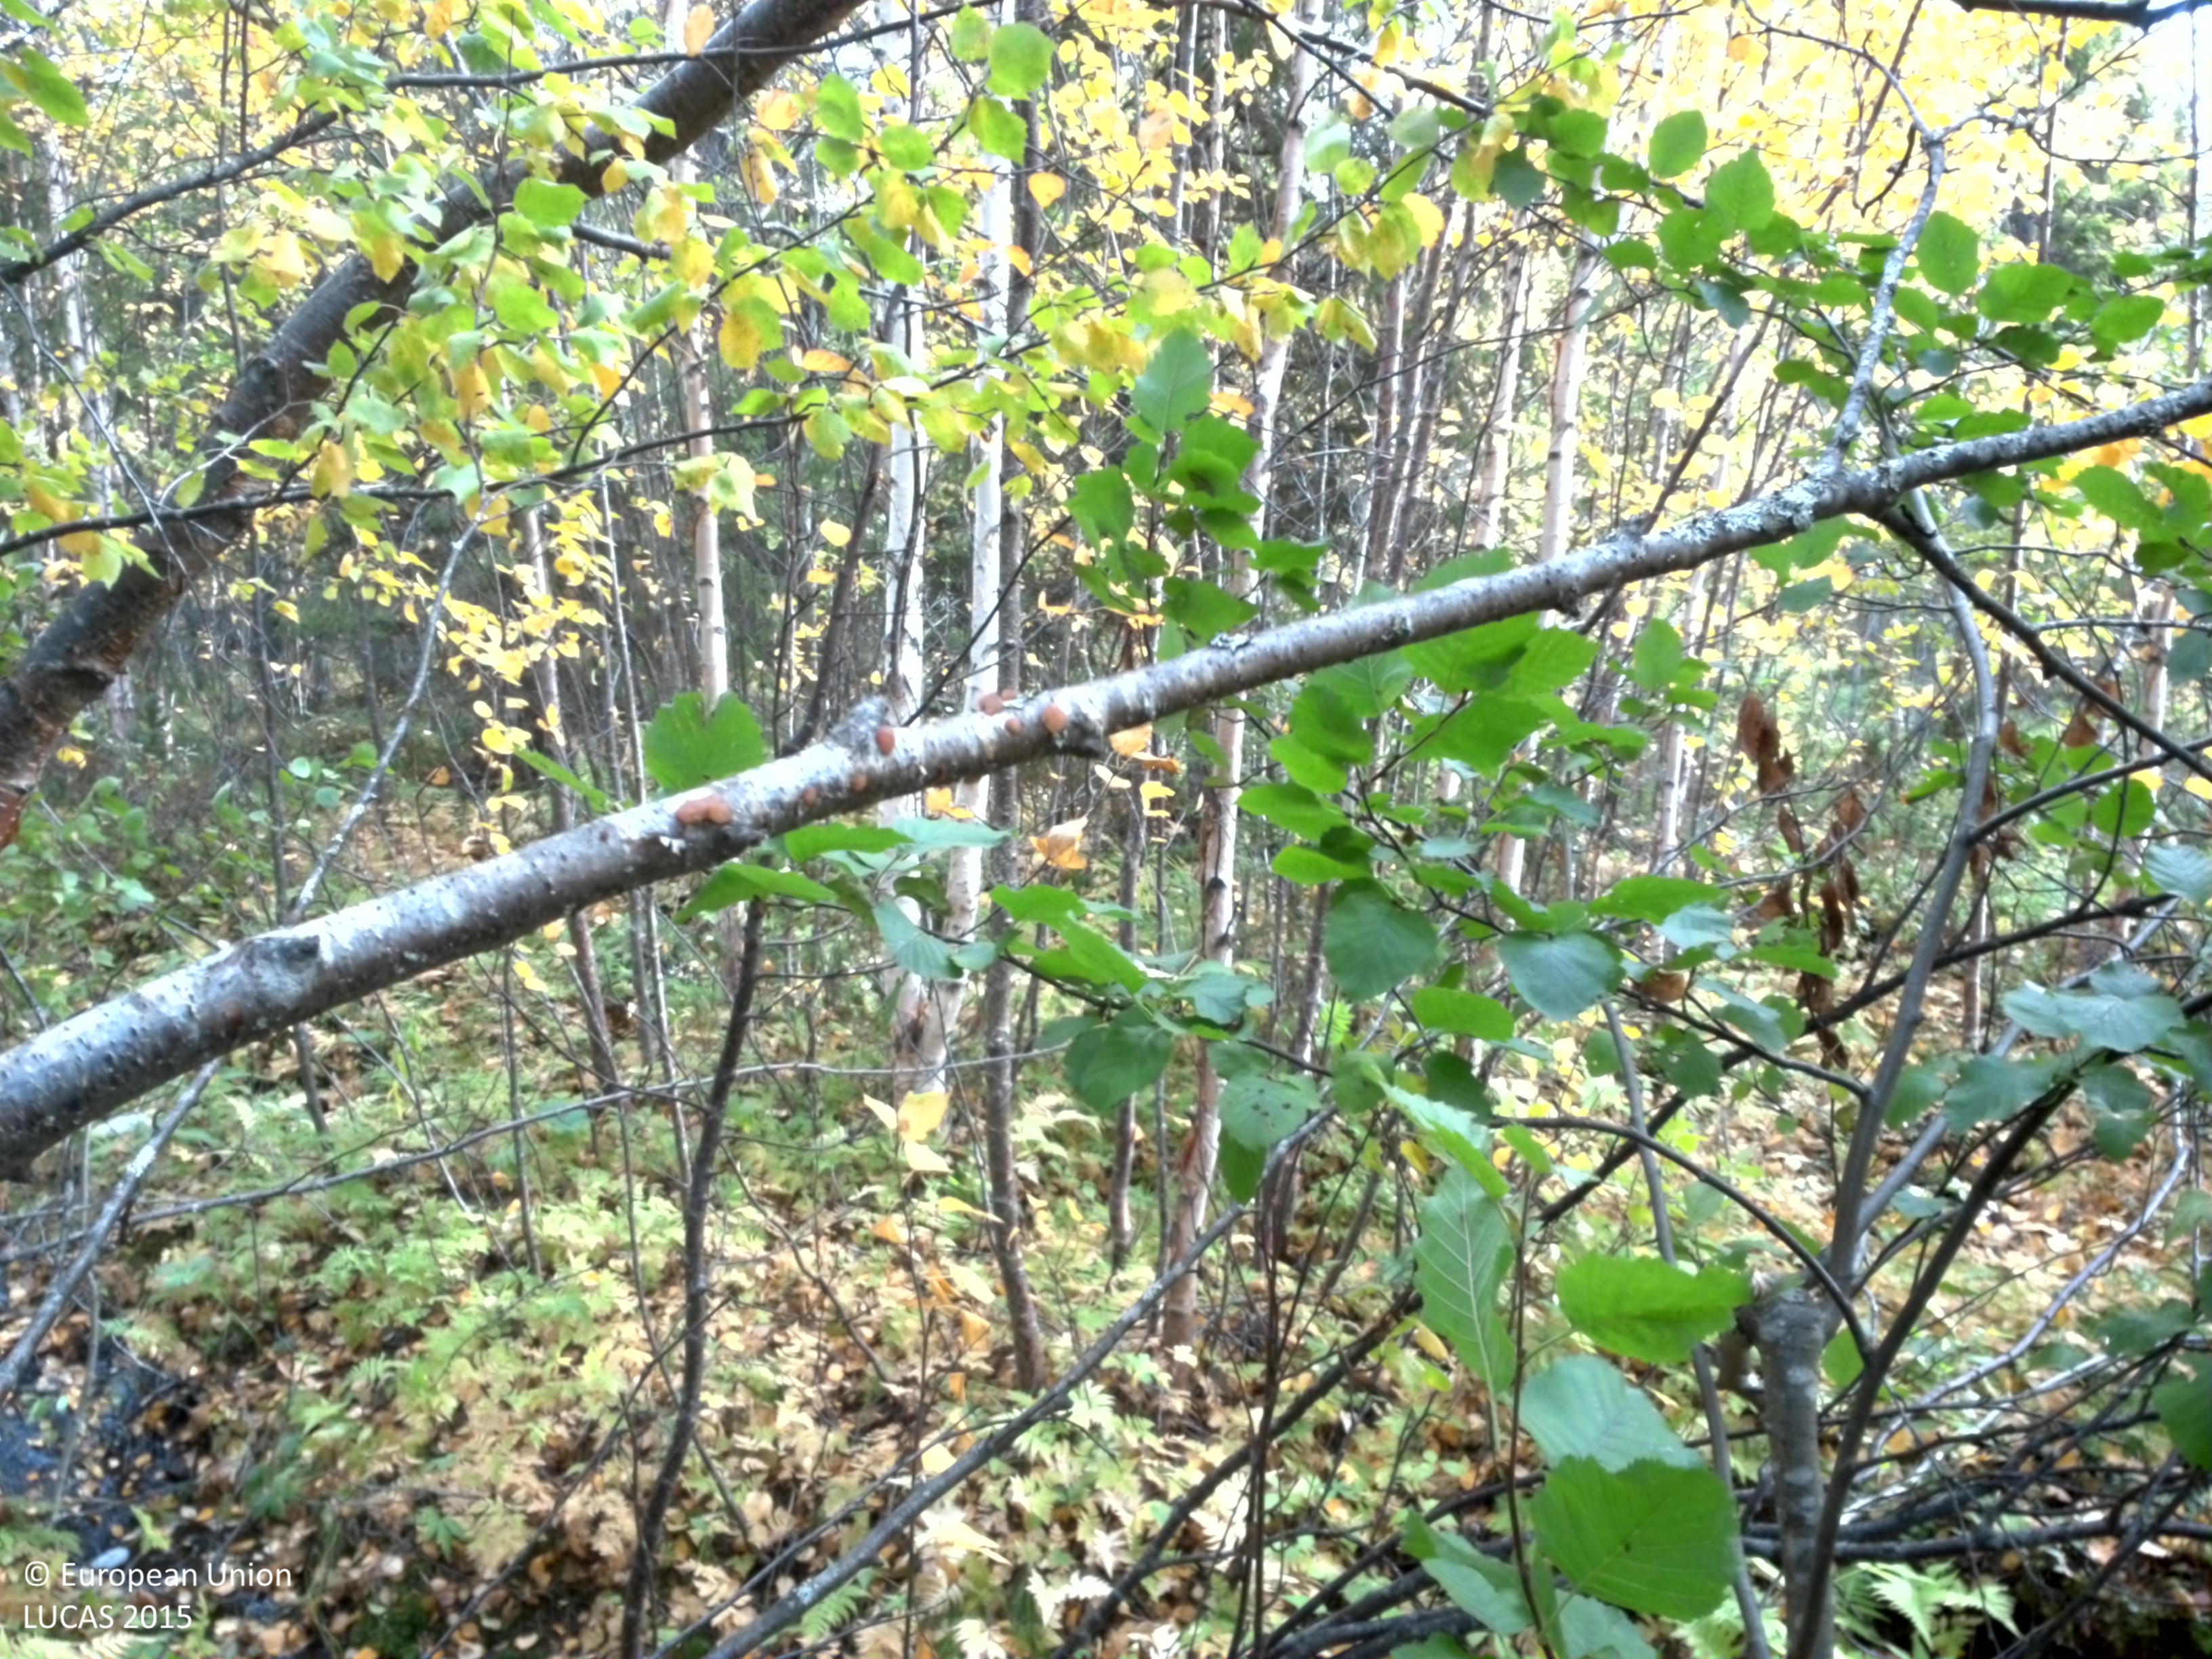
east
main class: Woodland
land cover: Broadleaved woodland
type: non-riverine alder, birch or aspen forest
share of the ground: > 75 %
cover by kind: broadleaved forest trees 70 %, herbaceous plants 15 %, coniferous forest trees 10 %, shrubs 5 %
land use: Semi-natural and natural areas not in use
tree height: > 5 m
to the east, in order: Broadleaved woodland; Ditches and canals; Spruce dominated mixed woodland; Spruce dominated coniferous woodland; Spruce dominated mixed woodland
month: September
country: SE
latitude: 65.3834
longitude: 16.1810
